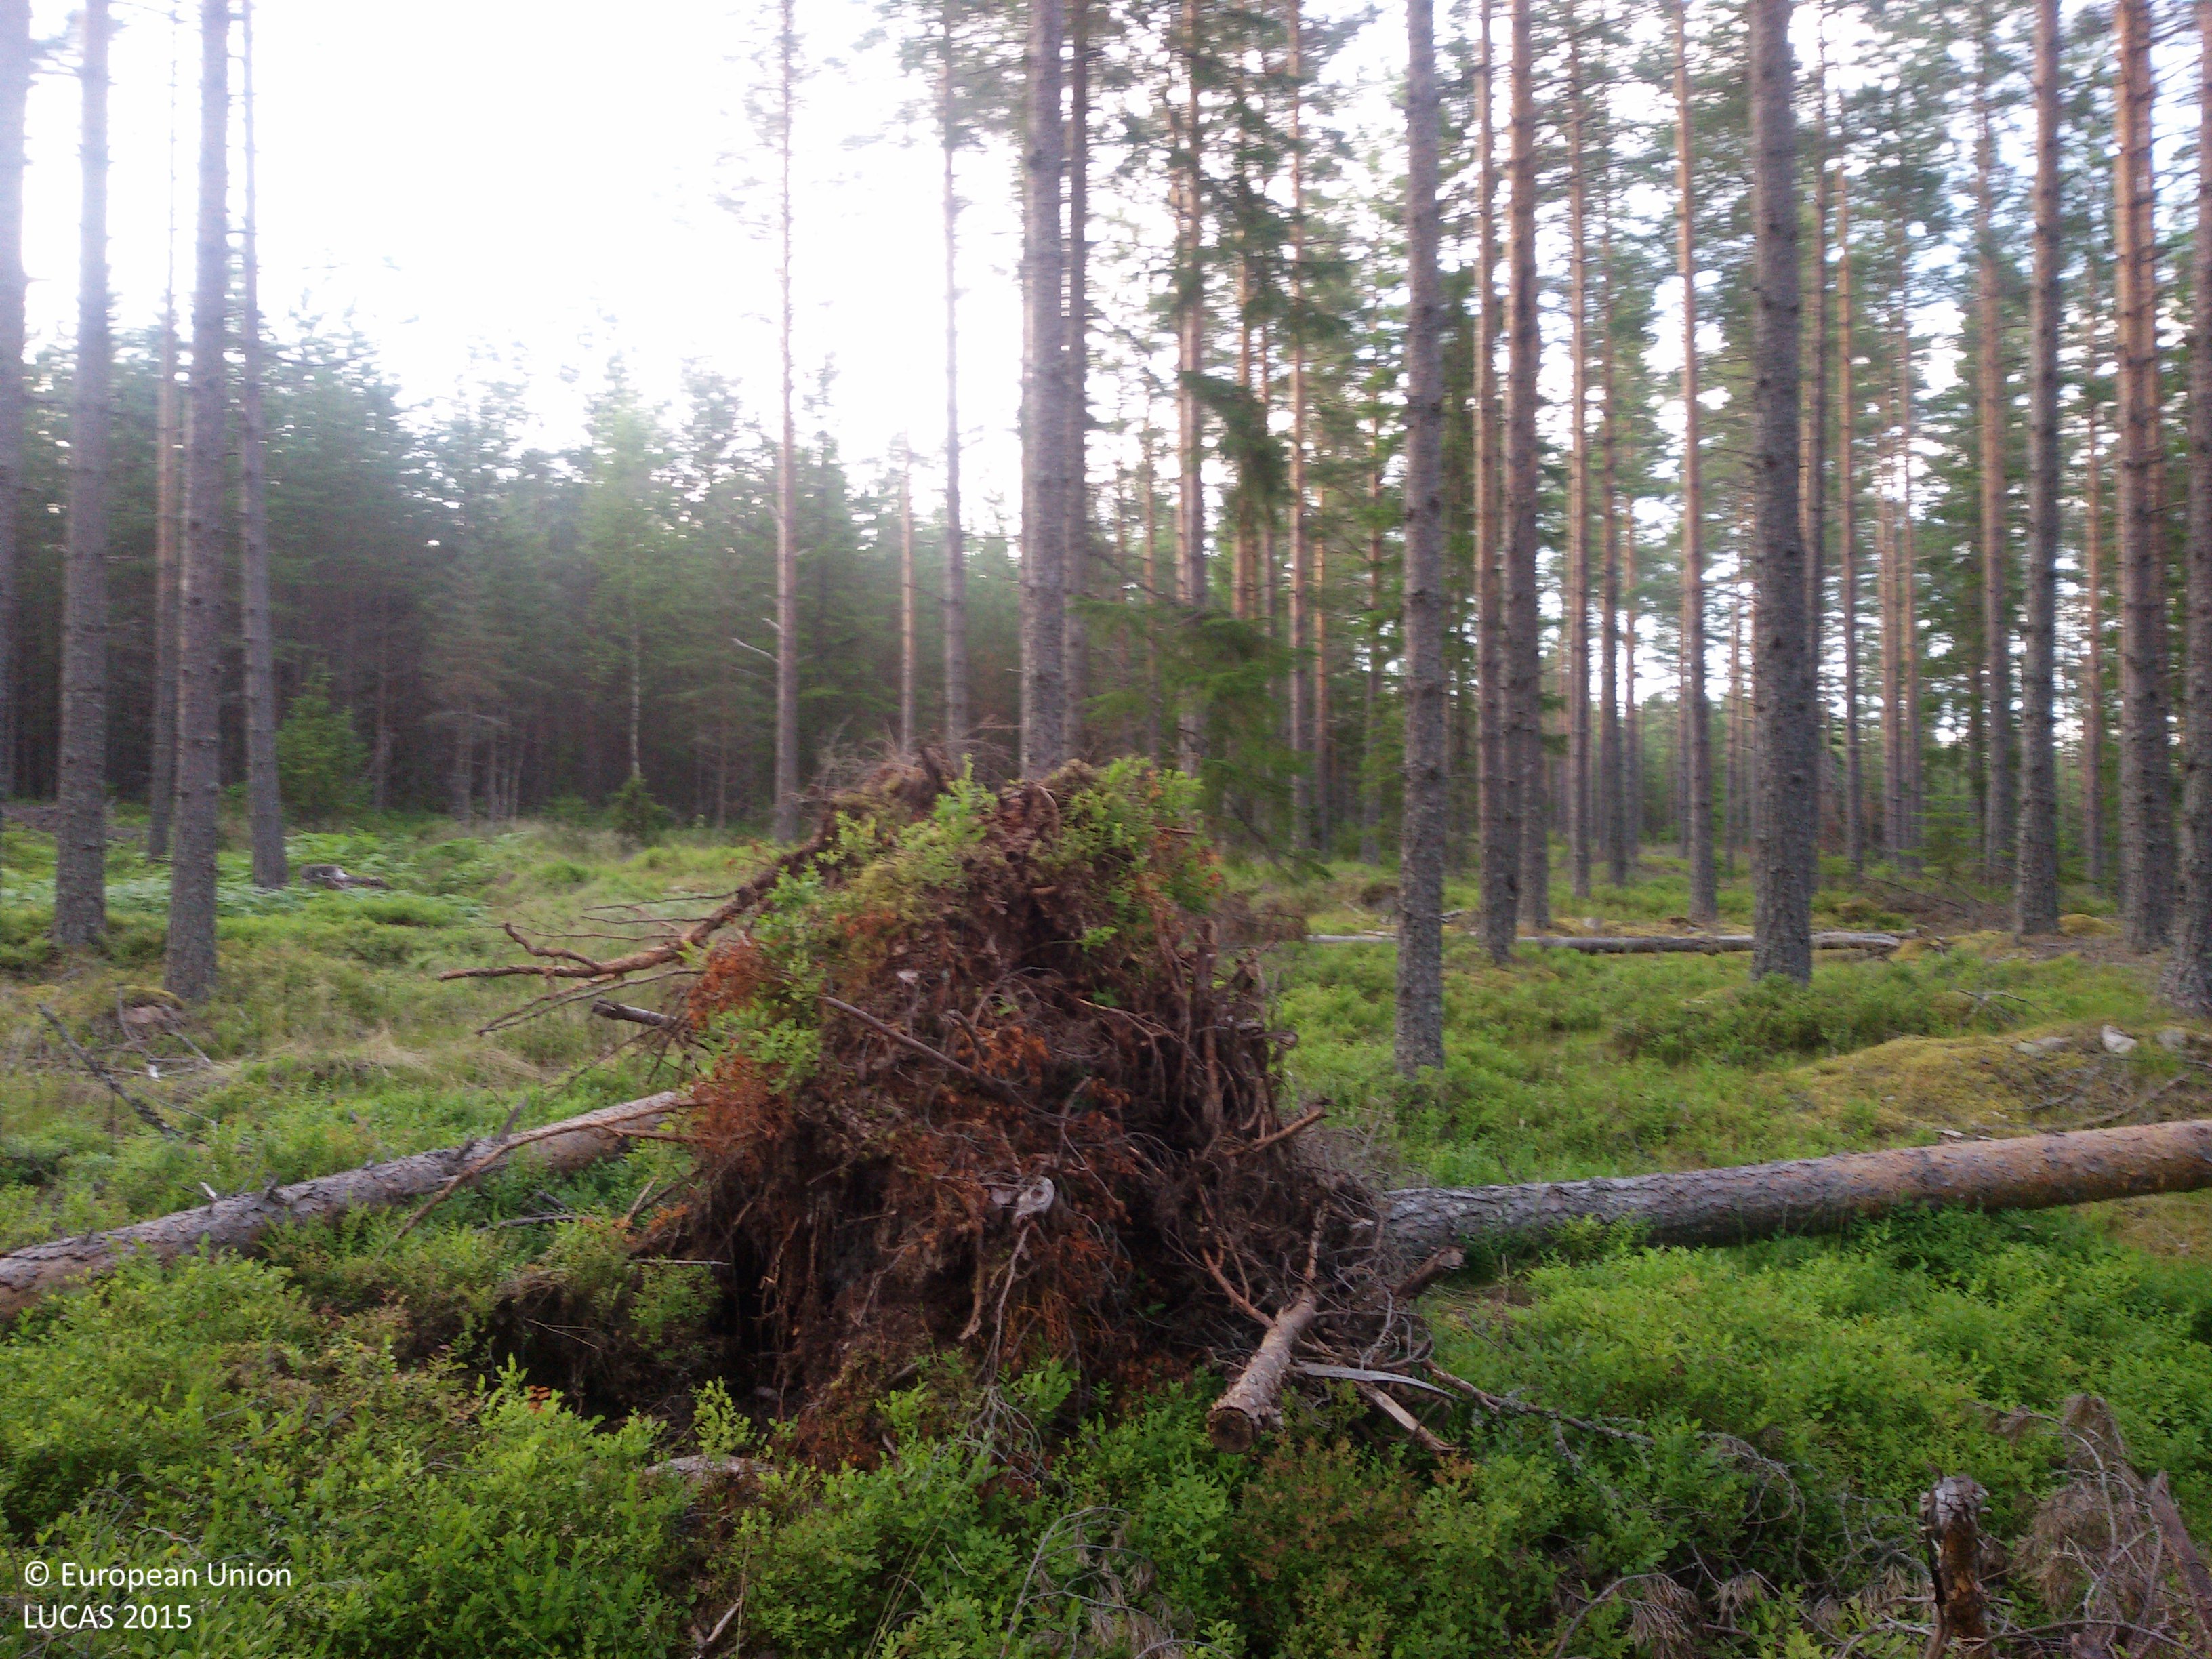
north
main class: Woodland
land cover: Pine dominated coniferous woodland
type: boreal forest
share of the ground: 50 - 75 %
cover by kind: coniferous forest trees 75 %, lichens and mosses 20 %, herbaceous plants 5 %
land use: Forestry
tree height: > 5 m
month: July
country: SE
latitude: 60.5264
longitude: 14.9619
